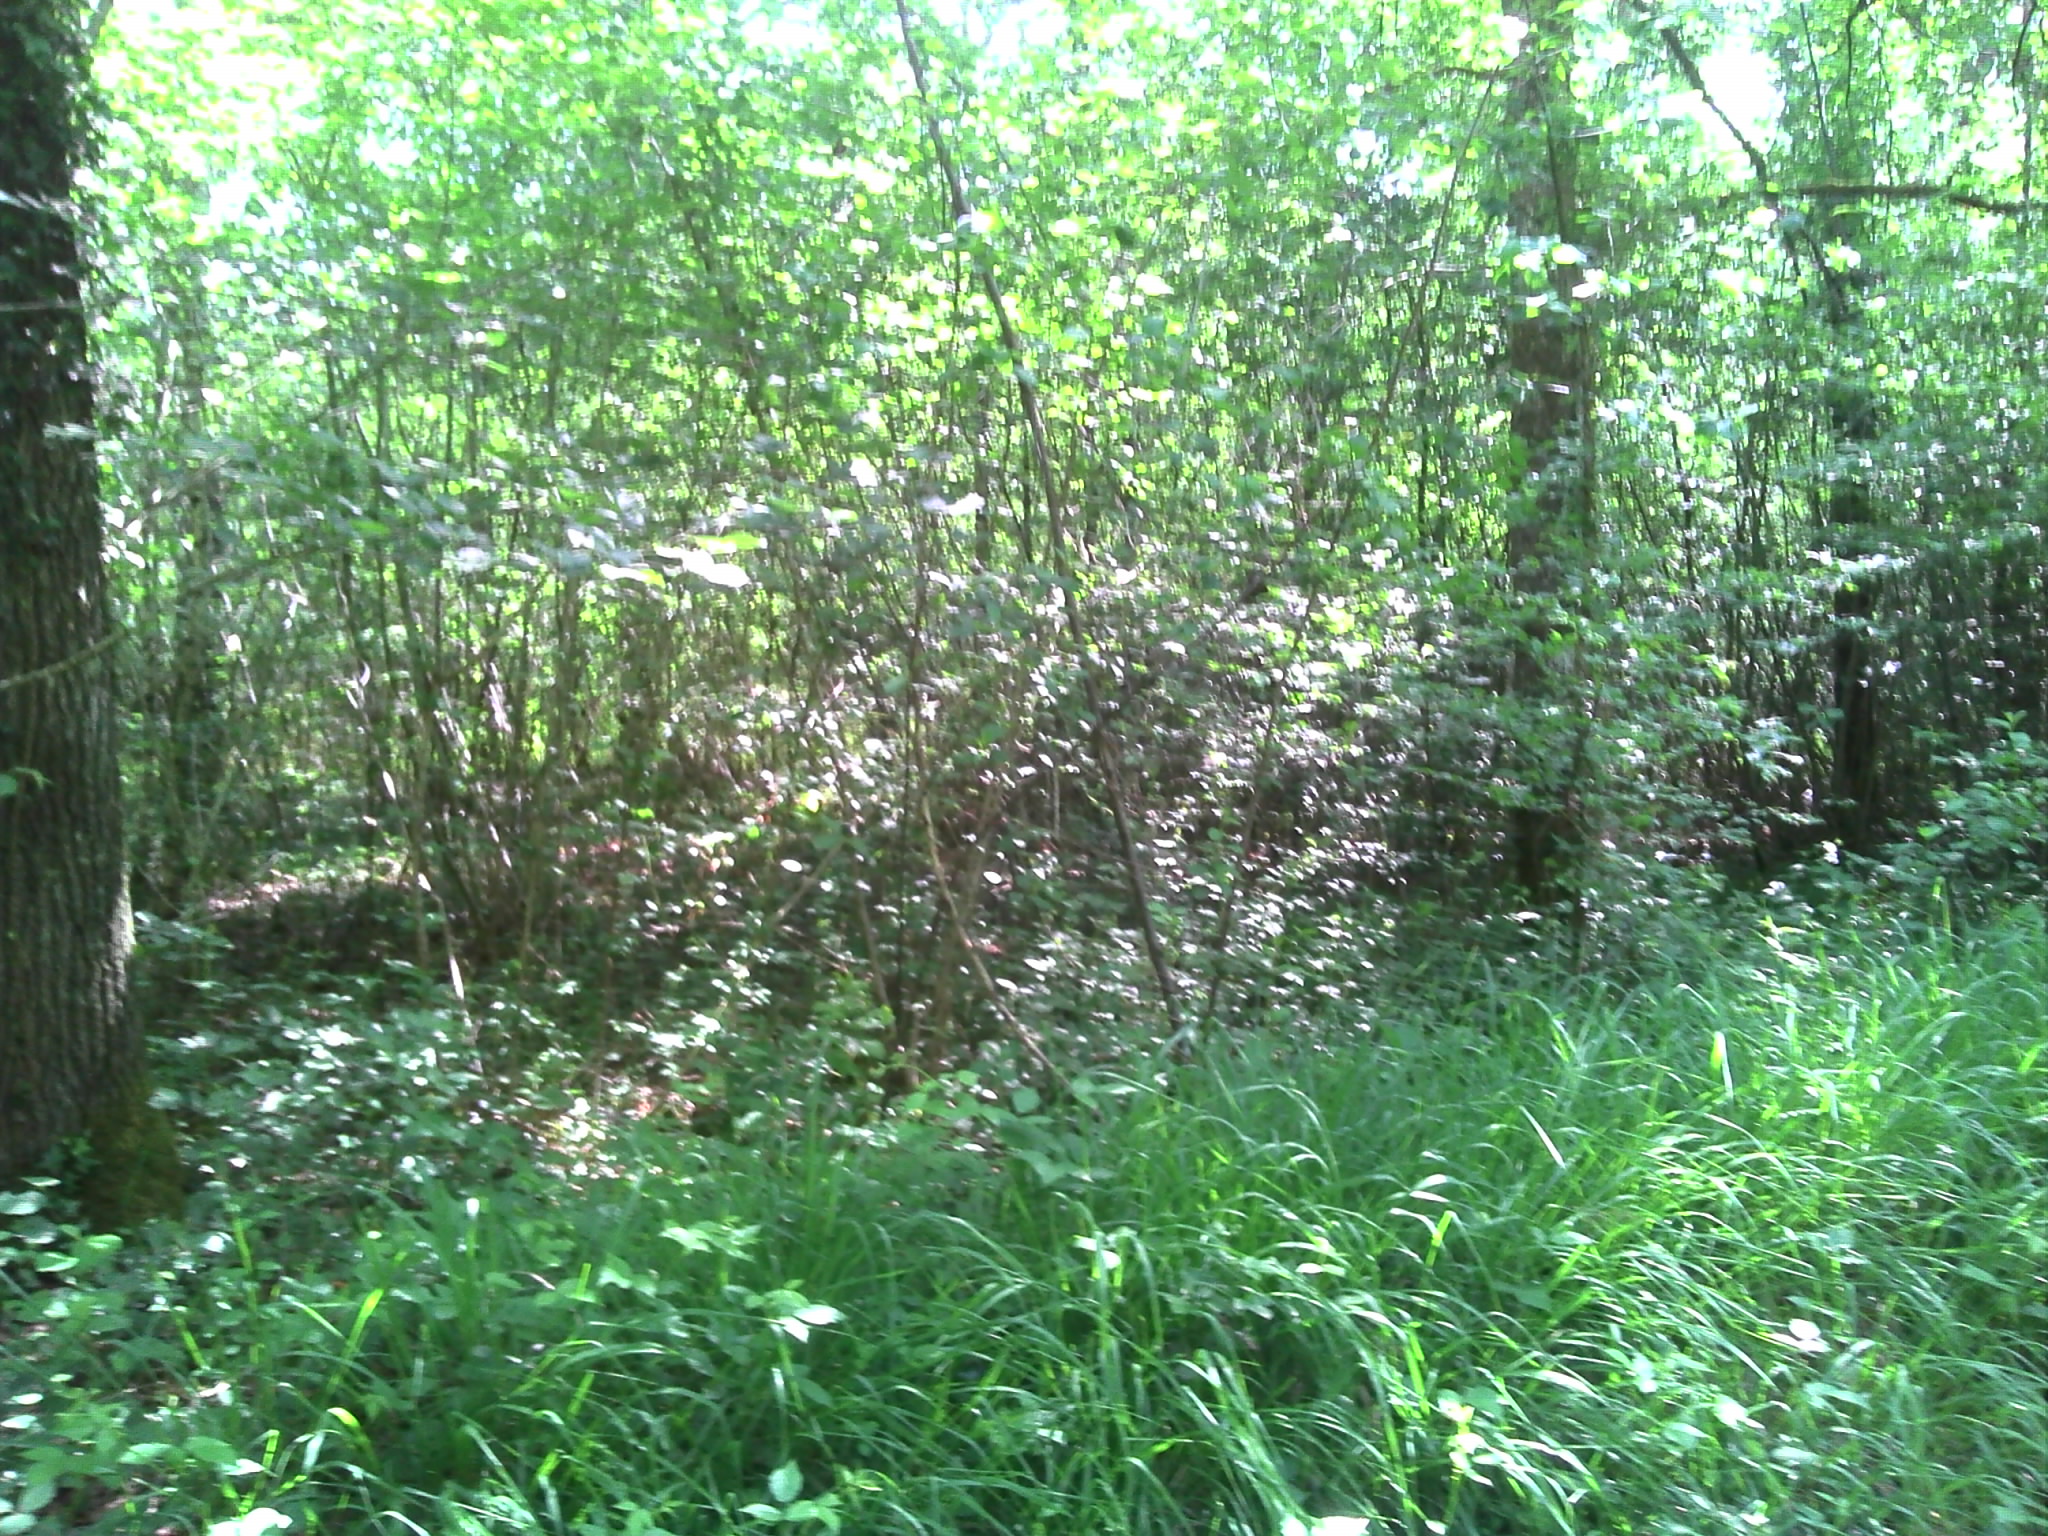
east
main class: Woodland
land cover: Broadleaved woodland
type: mesophytic deciduous forest
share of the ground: > 75 %
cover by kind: broadleaved forest trees 80 %, herbaceous plants 20 %
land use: Forestry
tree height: > 5 m
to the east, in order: Tracks; Broadleaved woodland
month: May
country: FR
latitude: 46.5654
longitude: 5.1360
